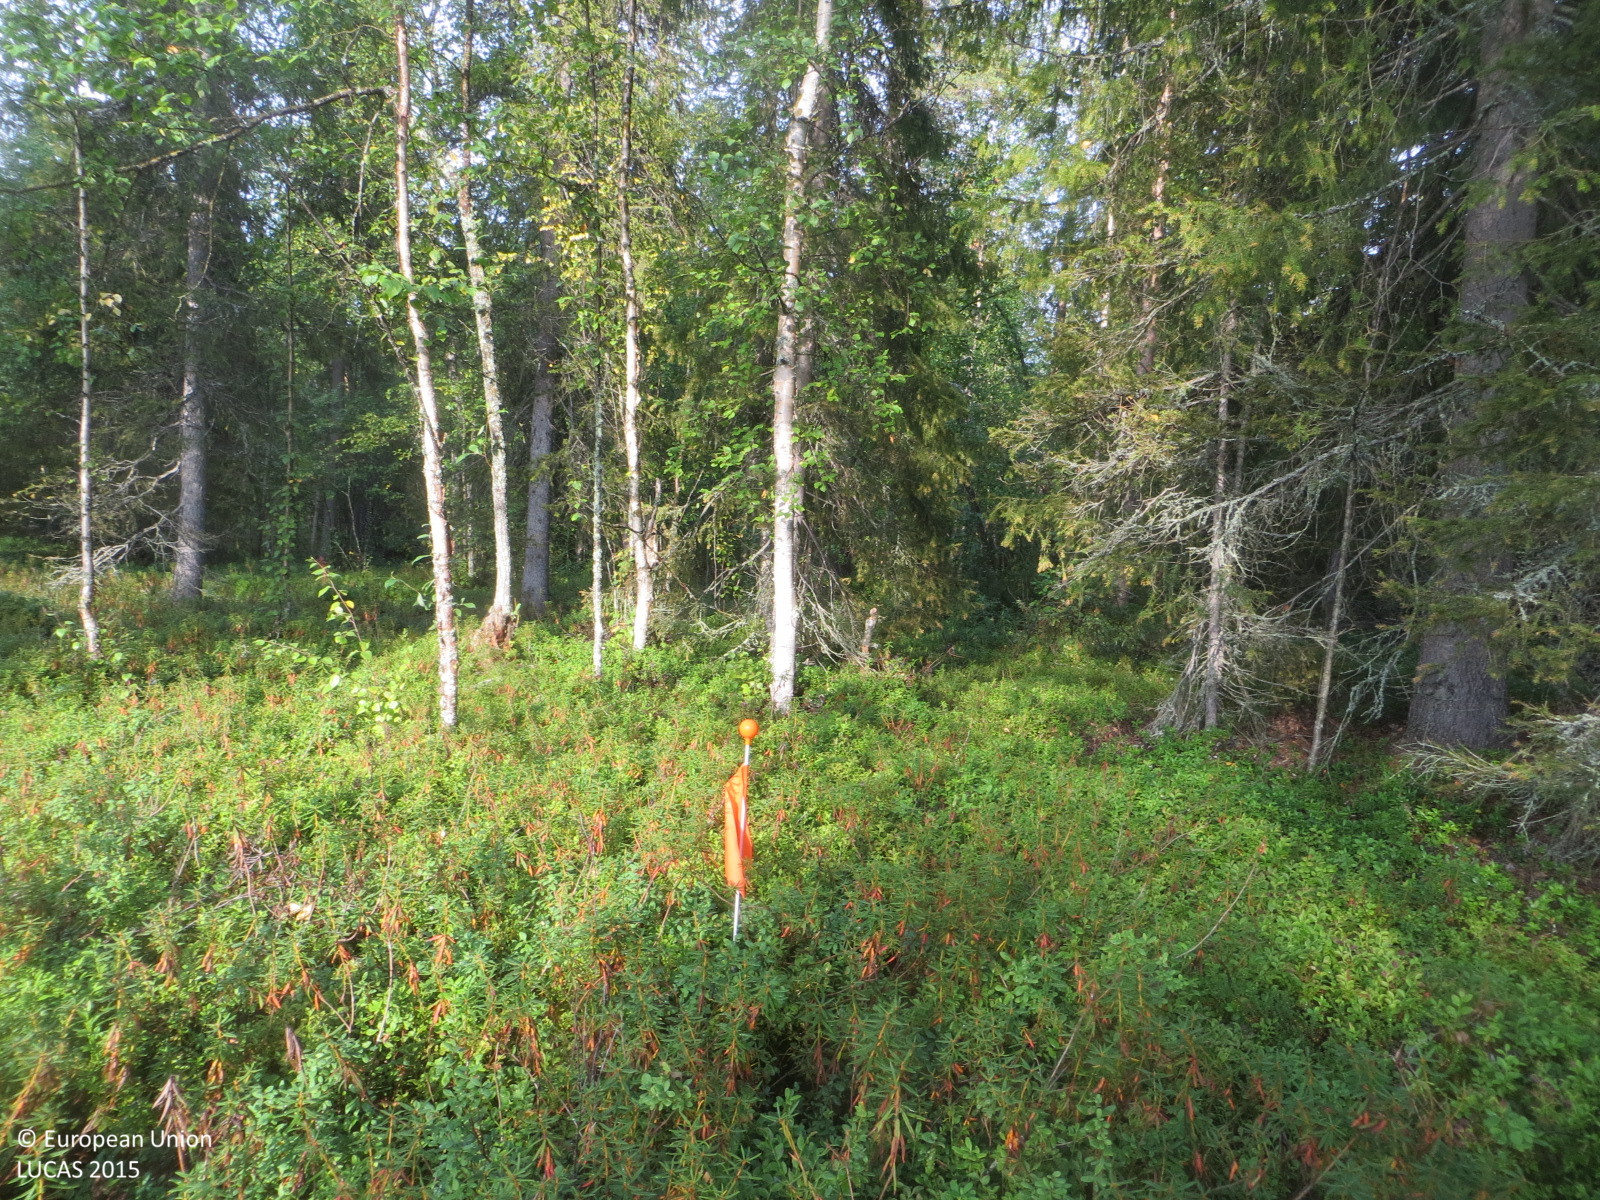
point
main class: Woodland
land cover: Other mixed woodland
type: boreal forest
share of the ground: 50 - 75 %
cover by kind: shrubs 40 %, coniferous forest trees 30 %, broadleaved forest trees 30 %
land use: Forestry
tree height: > 5 m
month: August
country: FI
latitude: 67.7948
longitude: 24.9000
